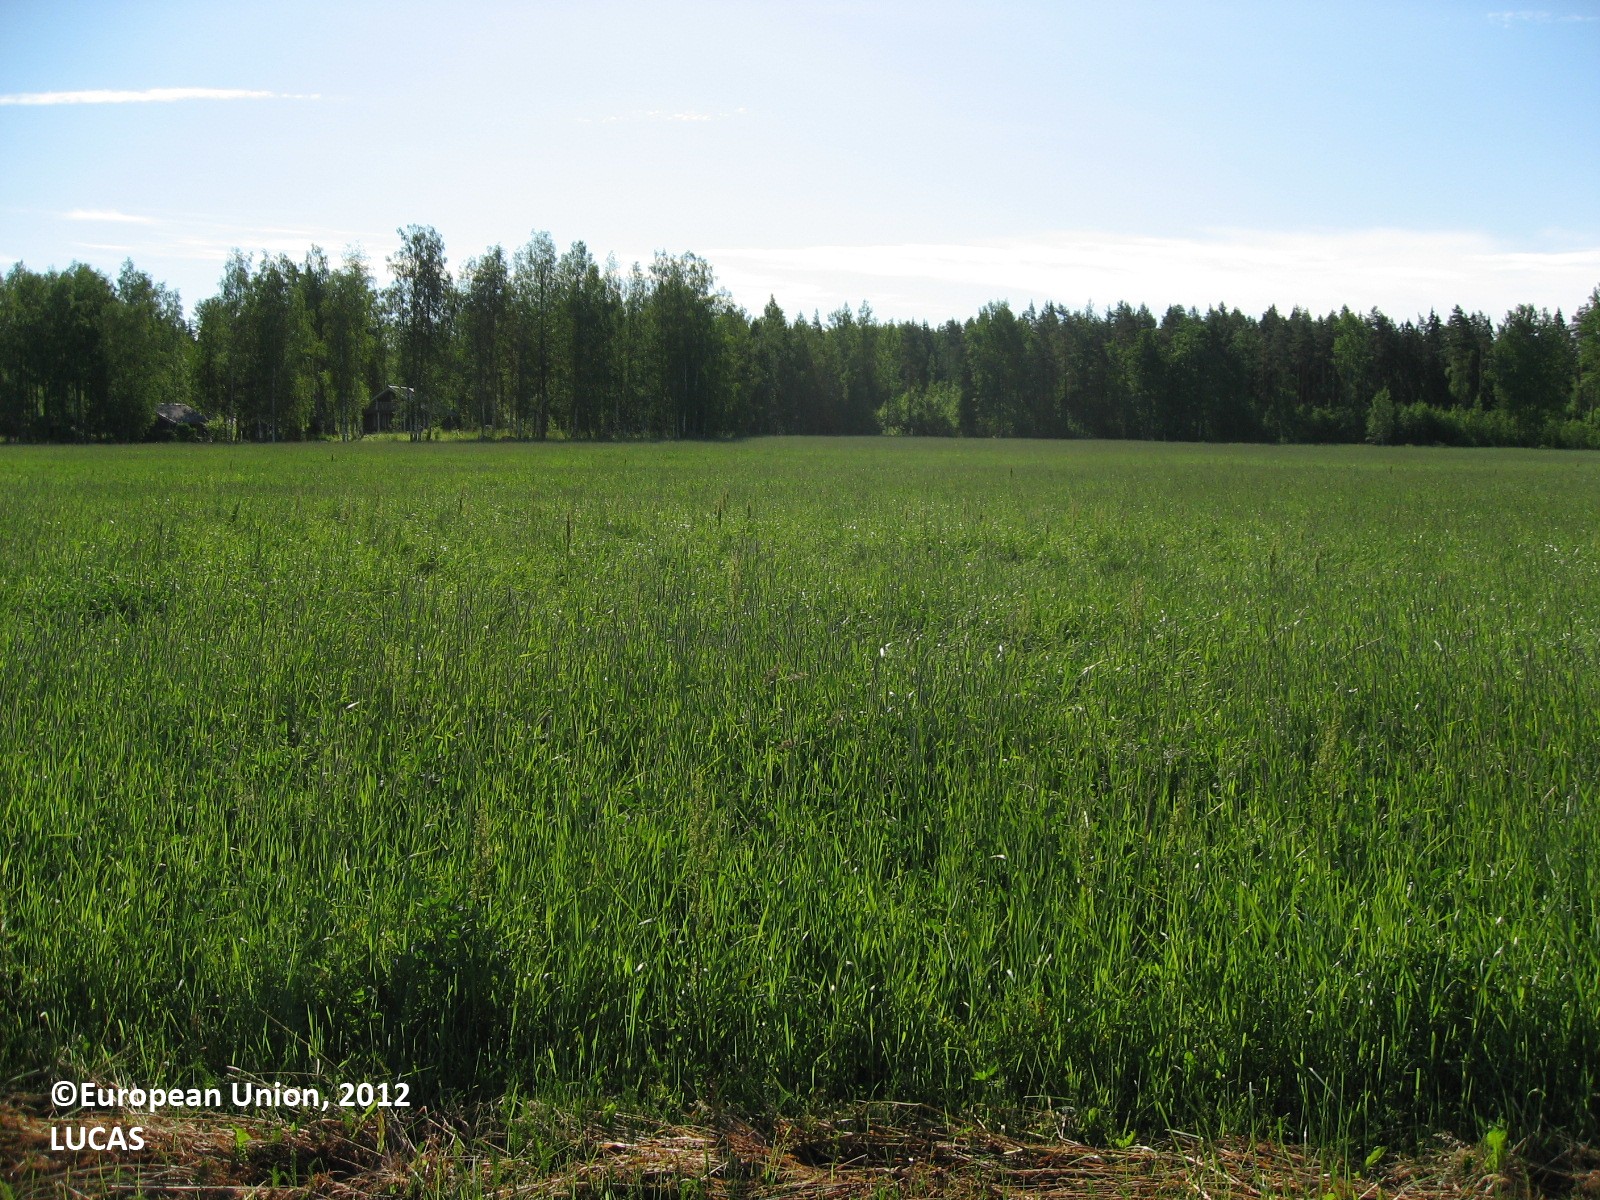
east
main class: Cropland
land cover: Dry pulses
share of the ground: 50 - 75 %
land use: Agriculture (excluding fallow land and kitchen gardens)
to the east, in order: Dry pulses; Grass margins; Tracks; Grass margins; Temporary grasslands; Ditches and canals; Broadleaved woodland; Artificial constructions in urban areas; Broadleaved woodland
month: June
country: FI
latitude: 60.6528
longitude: 26.3759
